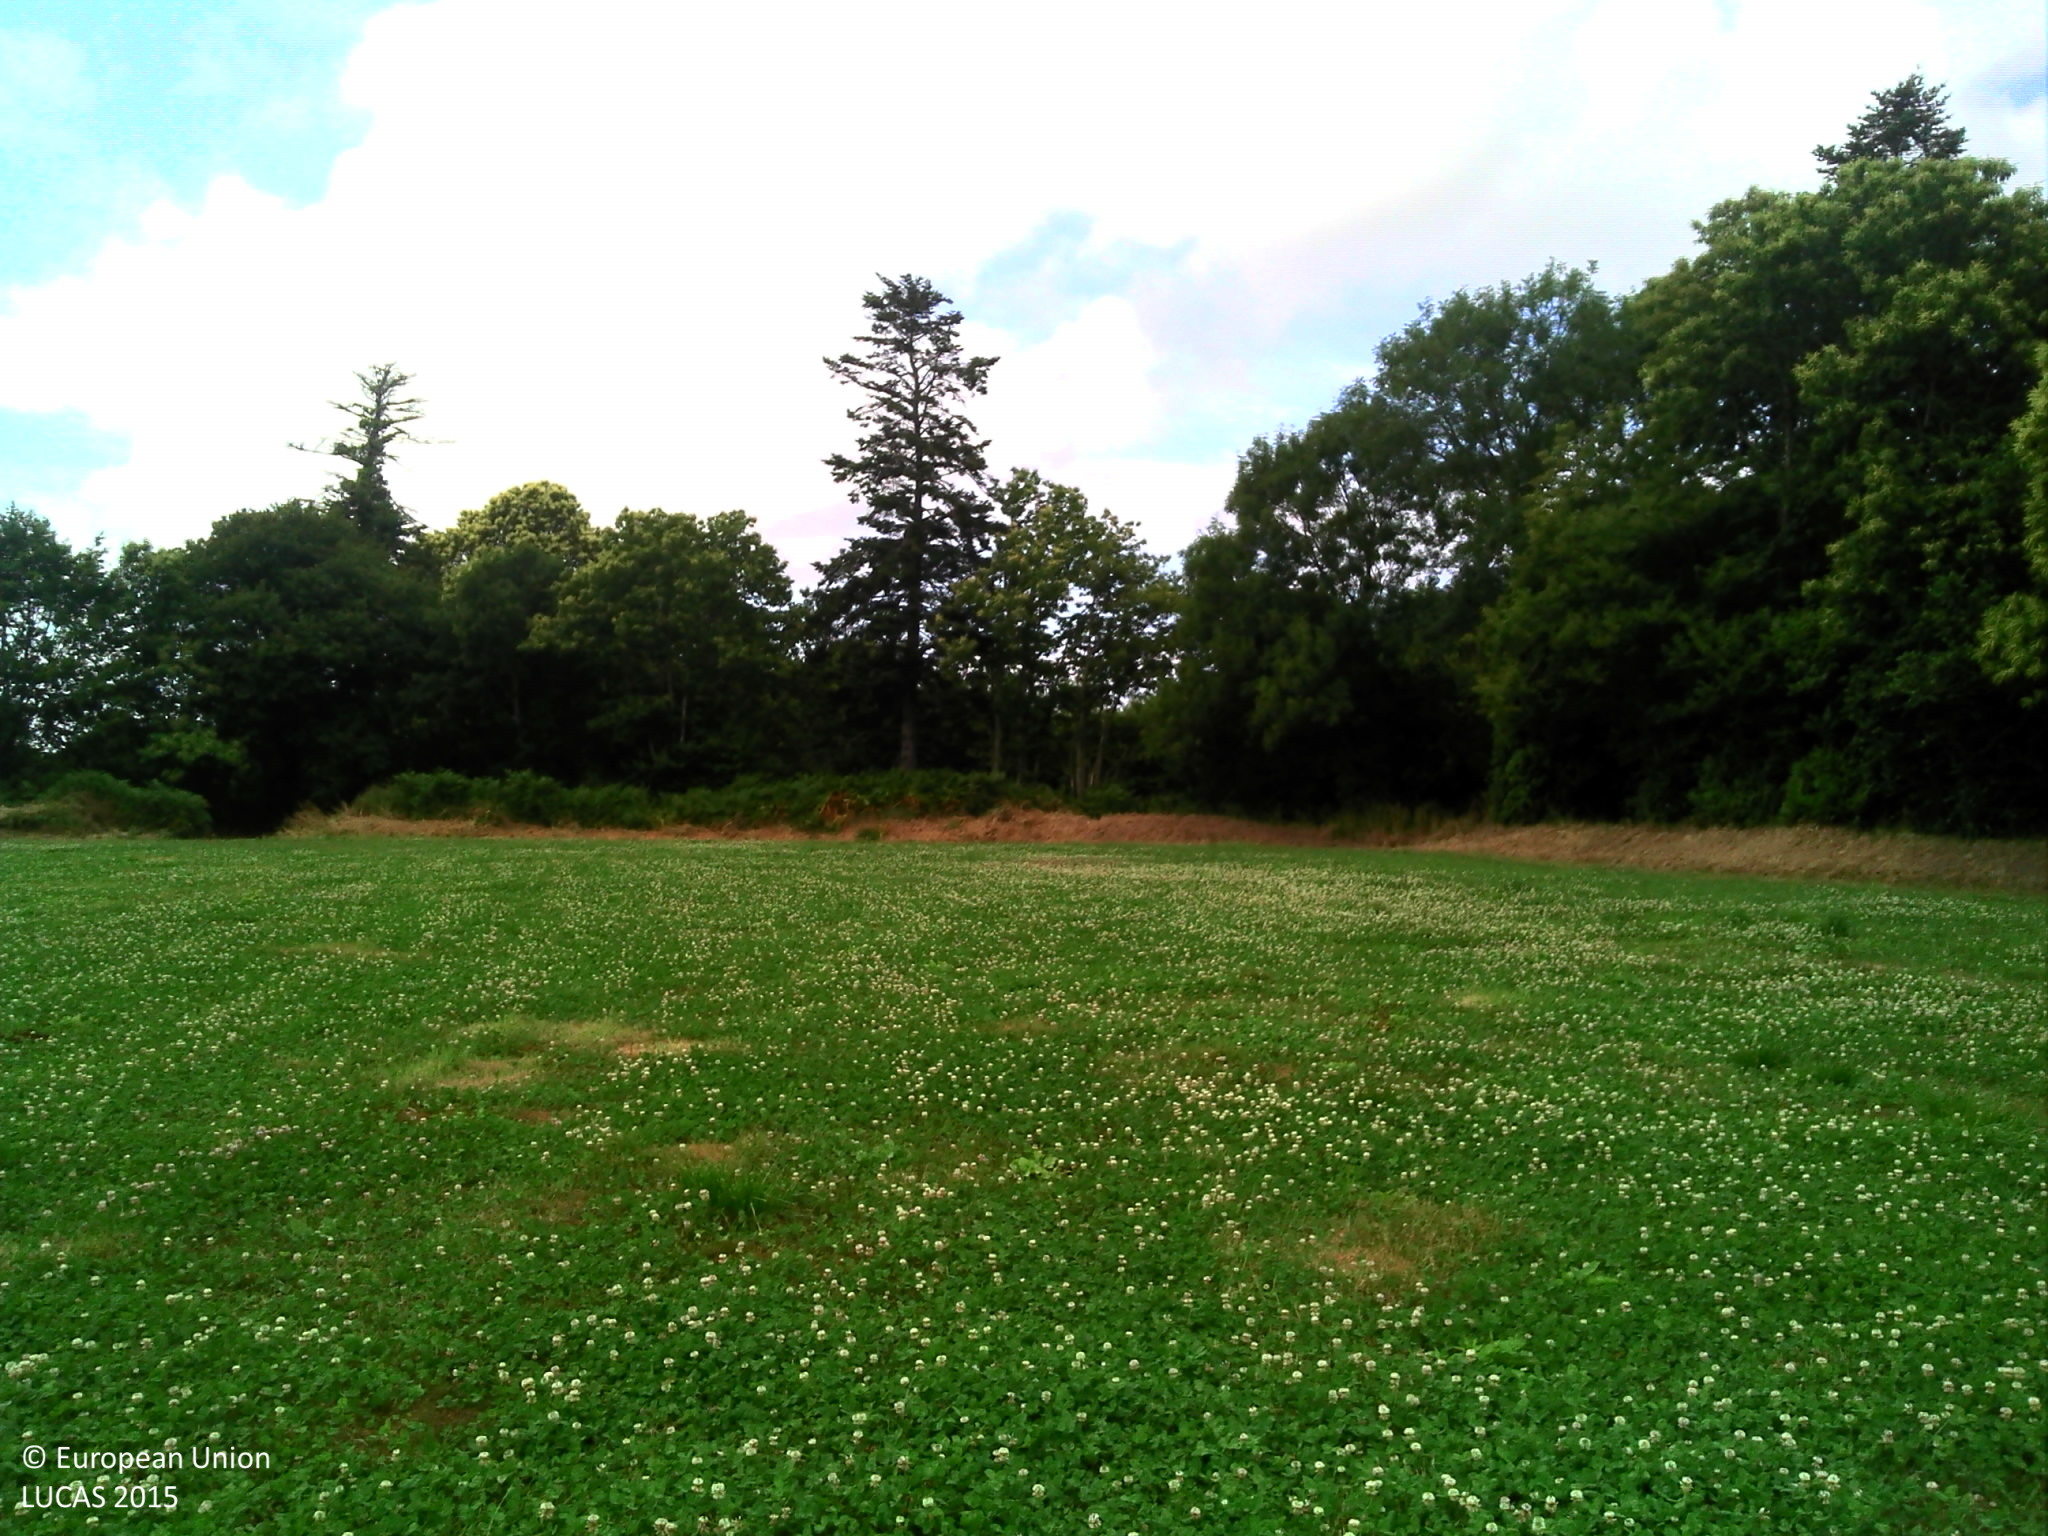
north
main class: Cropland
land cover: Clovers
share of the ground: > 75 %
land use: Agriculture (excluding fallow land and kitchen gardens)
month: July
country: FR
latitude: 48.6532
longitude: -3.4497
